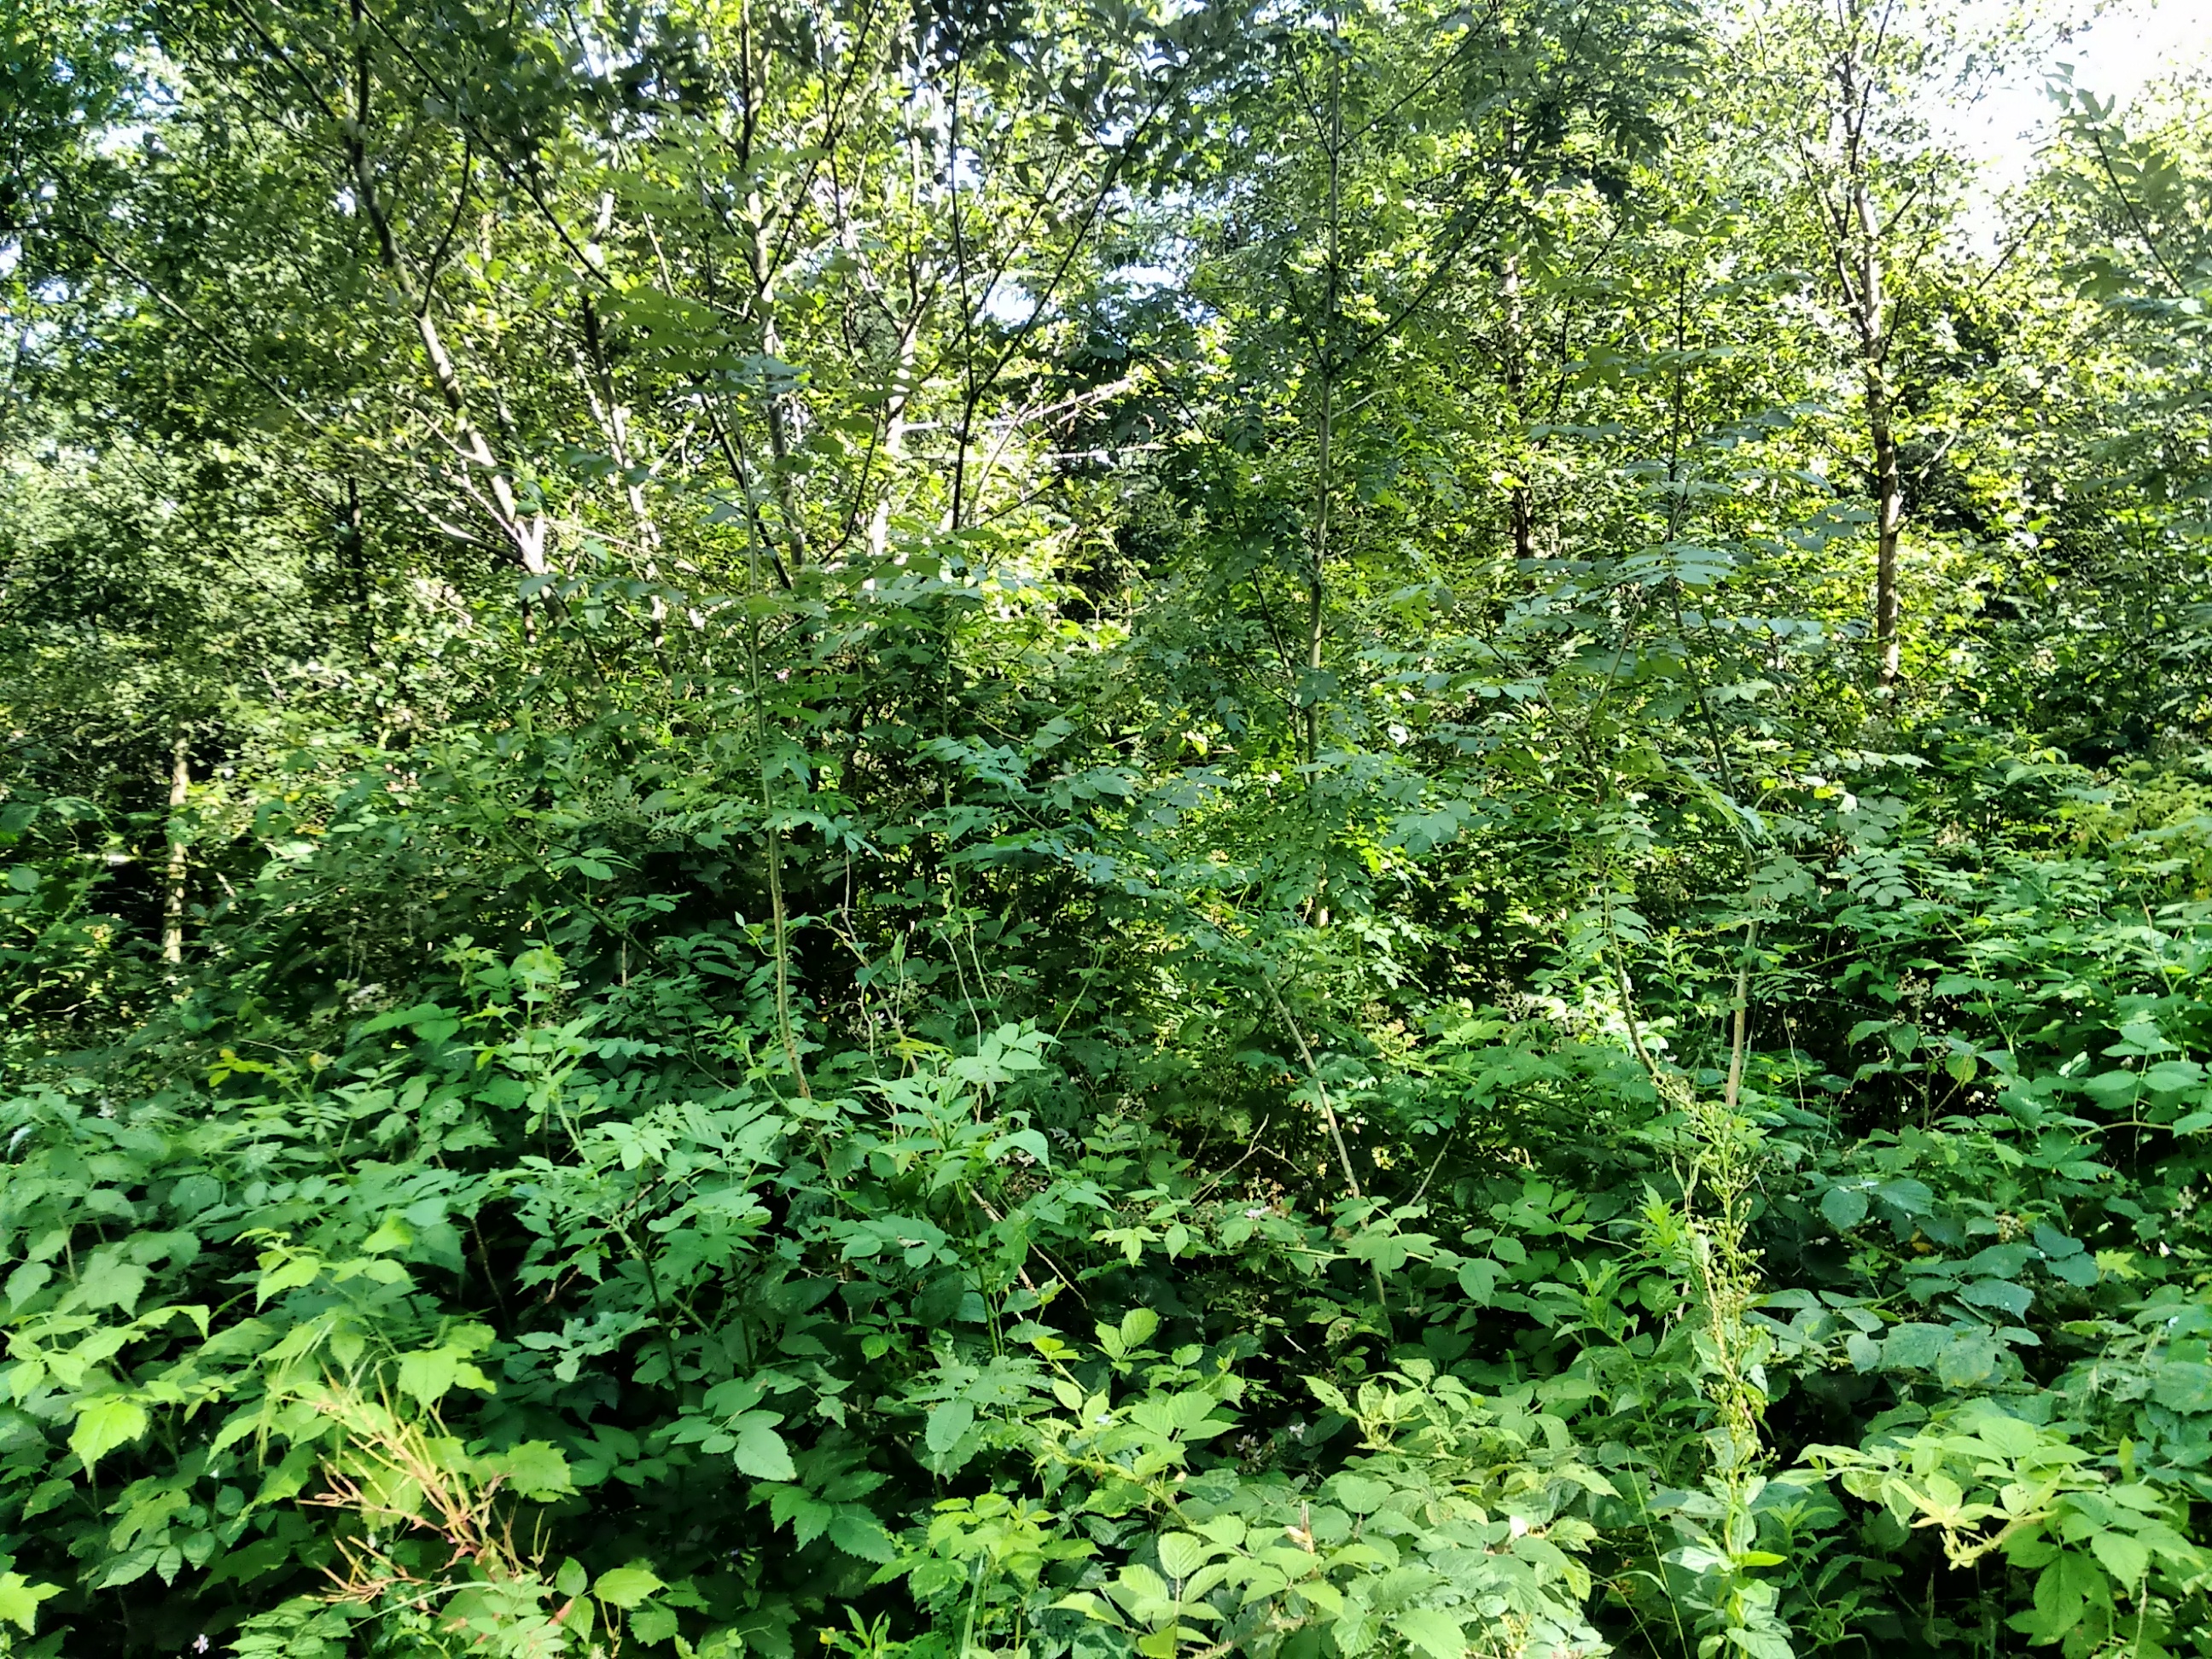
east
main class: Woodland
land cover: Other mixed woodland
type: exotic forest
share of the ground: > 75 %
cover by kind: coniferous forest trees 75 %, broadleaved forest trees 25 %
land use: Forestry
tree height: > 5 m
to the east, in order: Other mixed woodland; Tracks; Other coniferous woodland; Tracks; Other coniferous woodland; Abandoned hedges; Grass margins; Paved roads, cycling and walking lanes; Abandoned hedges; Fences; Grass margins; Artificial constructions; Grassland without tree/shrub cover
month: August
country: GB
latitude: 54.4764
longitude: -6.8164
